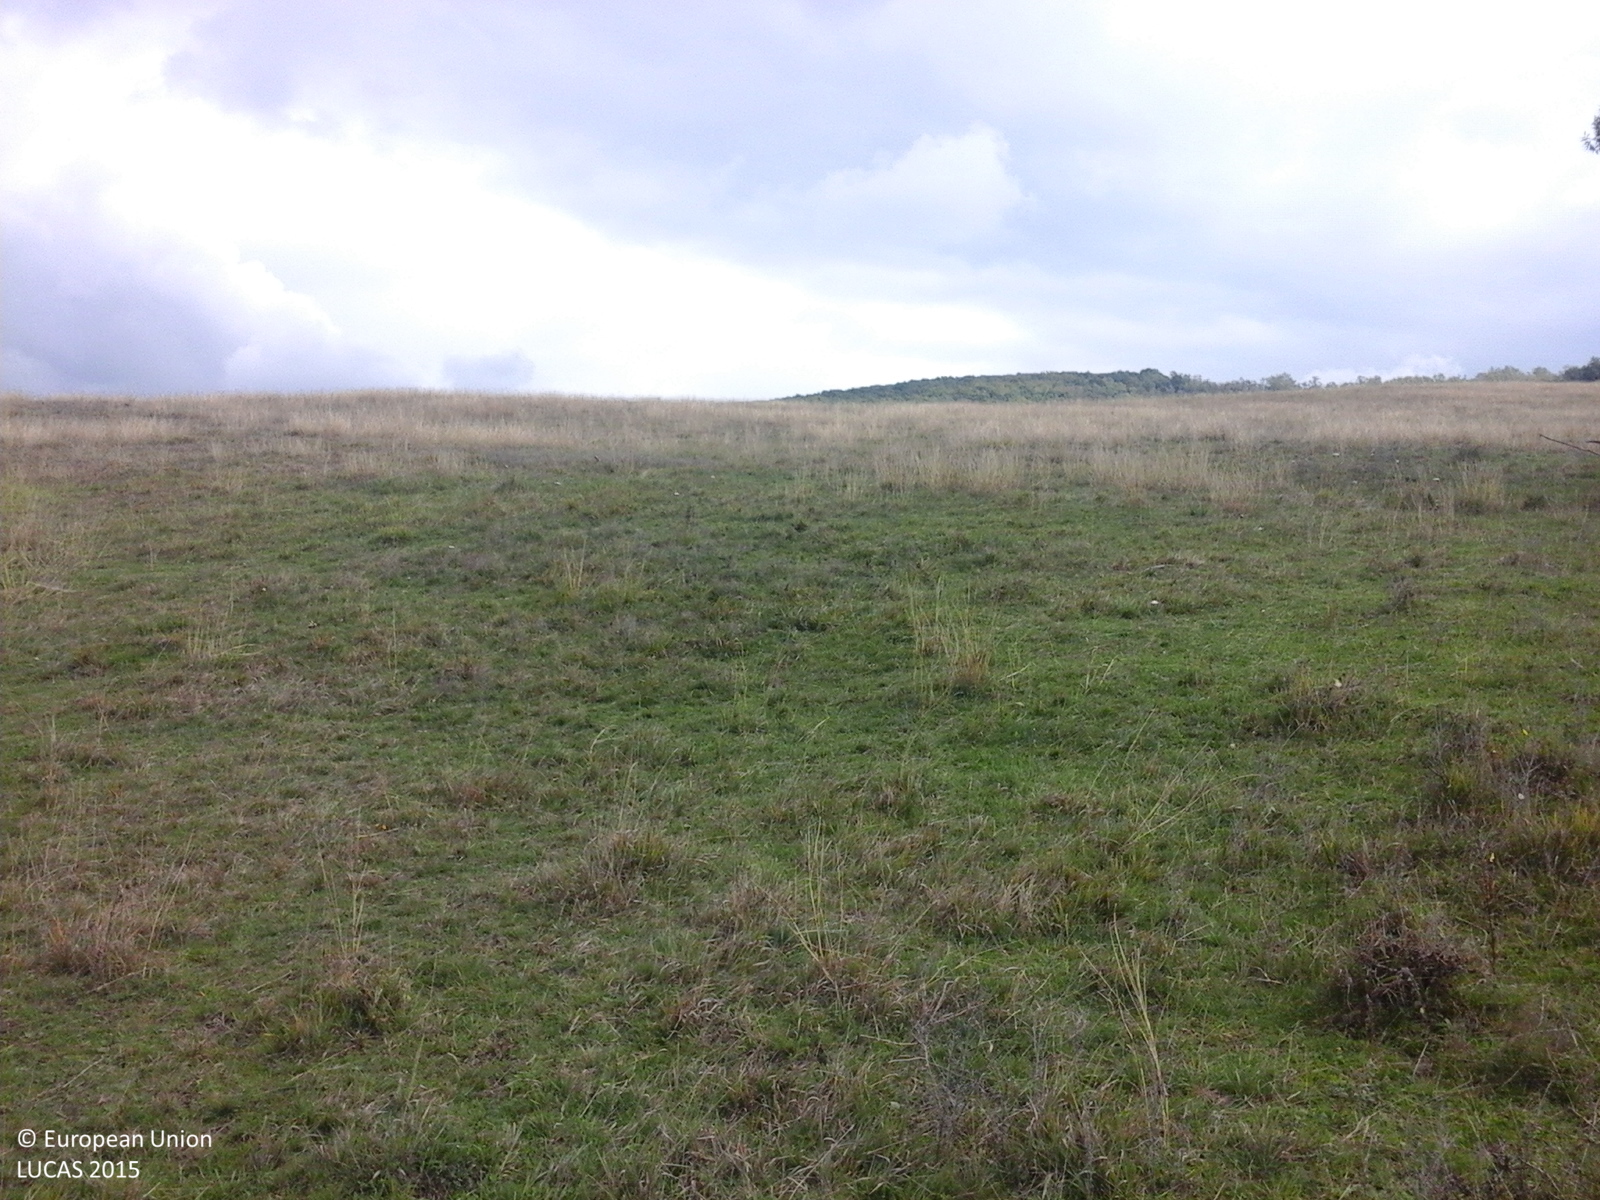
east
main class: Grassland
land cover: Grassland without tree/shrub cover
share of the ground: > 75 %
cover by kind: herbaceous plants 100 %
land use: Agriculture (excluding fallow land and kitchen gardens)
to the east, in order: Grassland without tree/shrub cover; Grassland with sparse tree/shrub cover
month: October
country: RO
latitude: 46.0370
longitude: 24.0685
